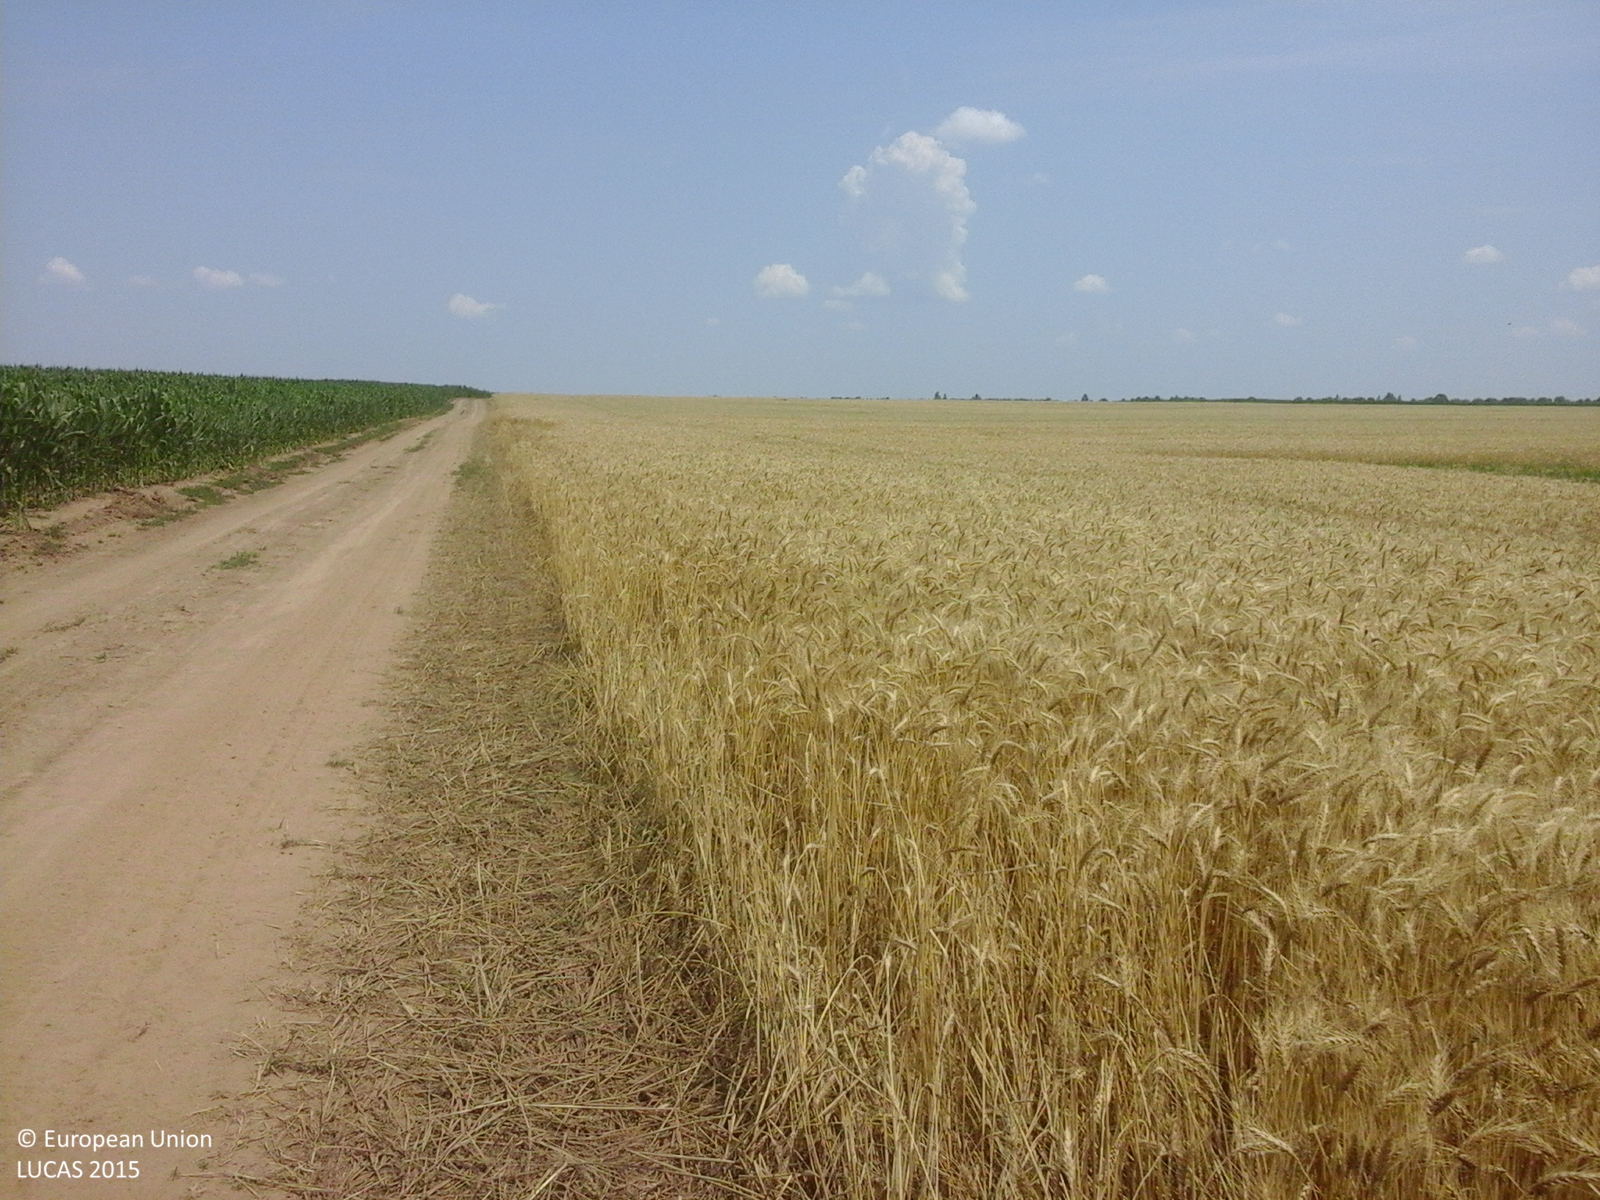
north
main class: Cropland
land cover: Common wheat
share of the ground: > 75 %
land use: Agriculture (excluding fallow land and kitchen gardens)
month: July
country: RO
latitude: 44.1788
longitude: 26.4855
